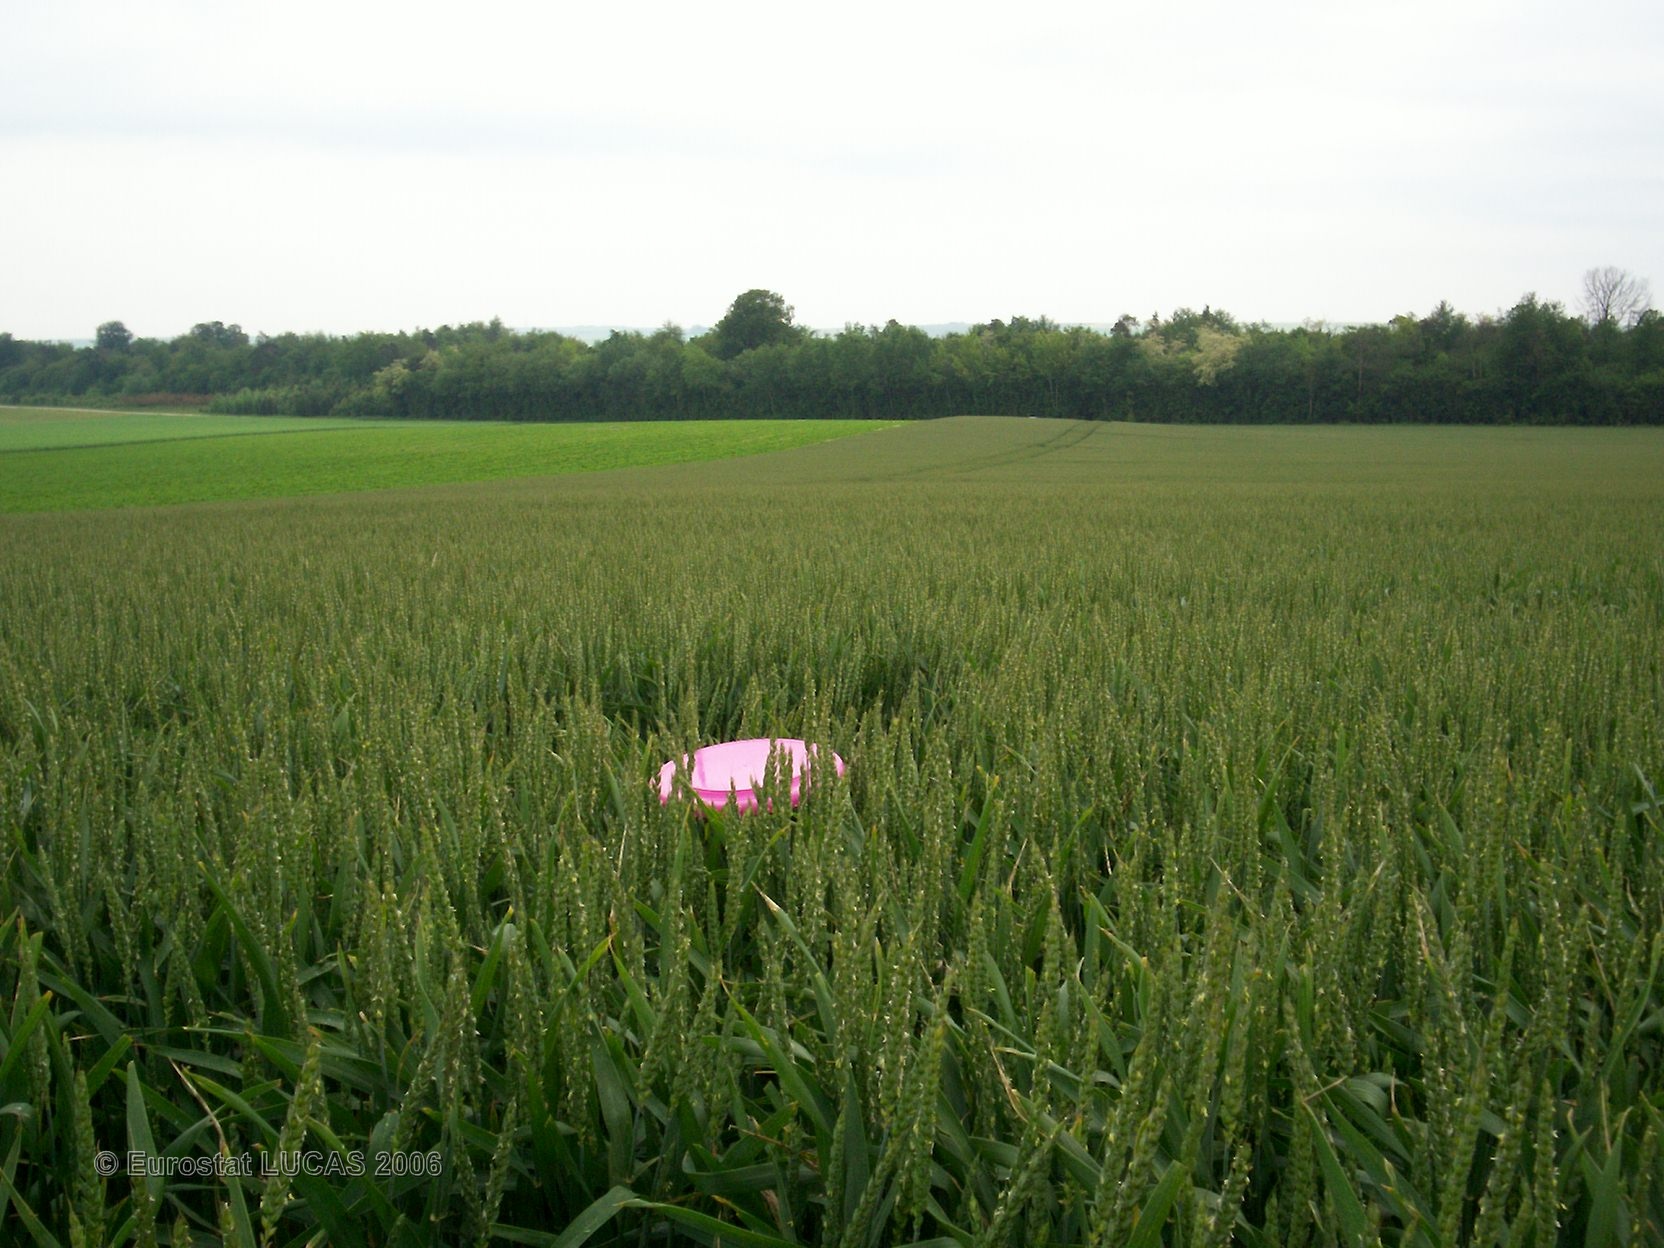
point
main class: Cropland
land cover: Common wheat
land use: Agriculture (excluding fallow land and kitchen gardens)
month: June
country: FR
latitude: 48.7516
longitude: 4.4611
